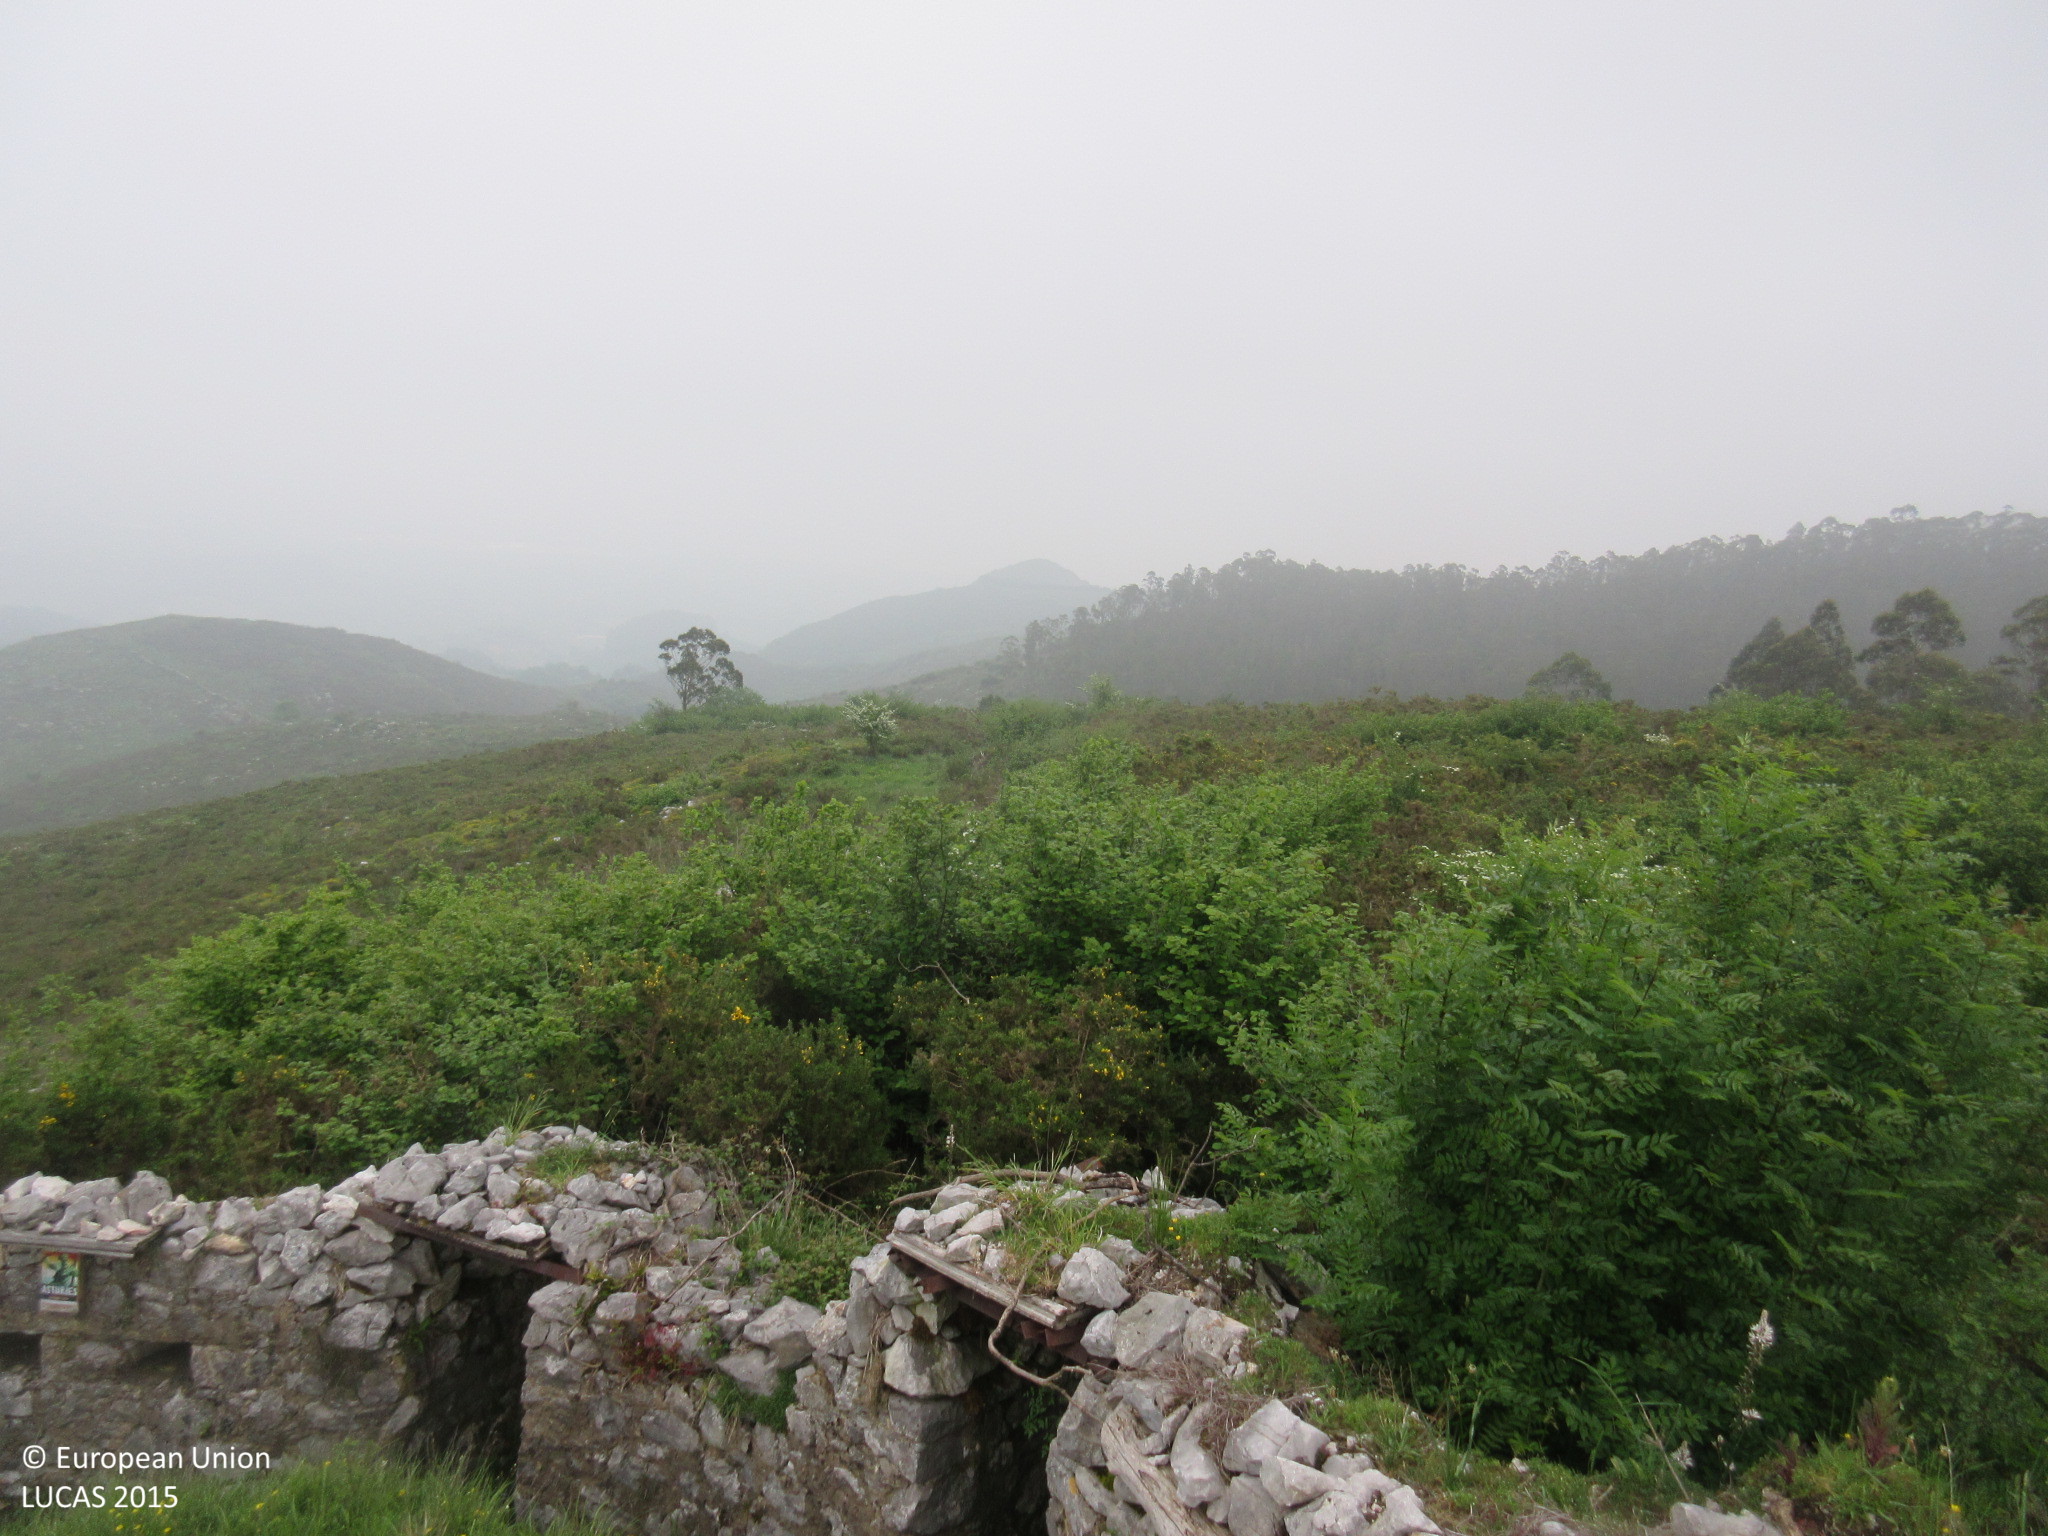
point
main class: Shrubland
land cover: Shrubland with sparse tree cover
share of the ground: > 75 %
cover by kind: shrubs 95 %, broadleaved forest trees 5 %
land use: Semi-natural and natural areas not in use
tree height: > 5 m
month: May
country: ES
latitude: 43.3938
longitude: -5.8791
